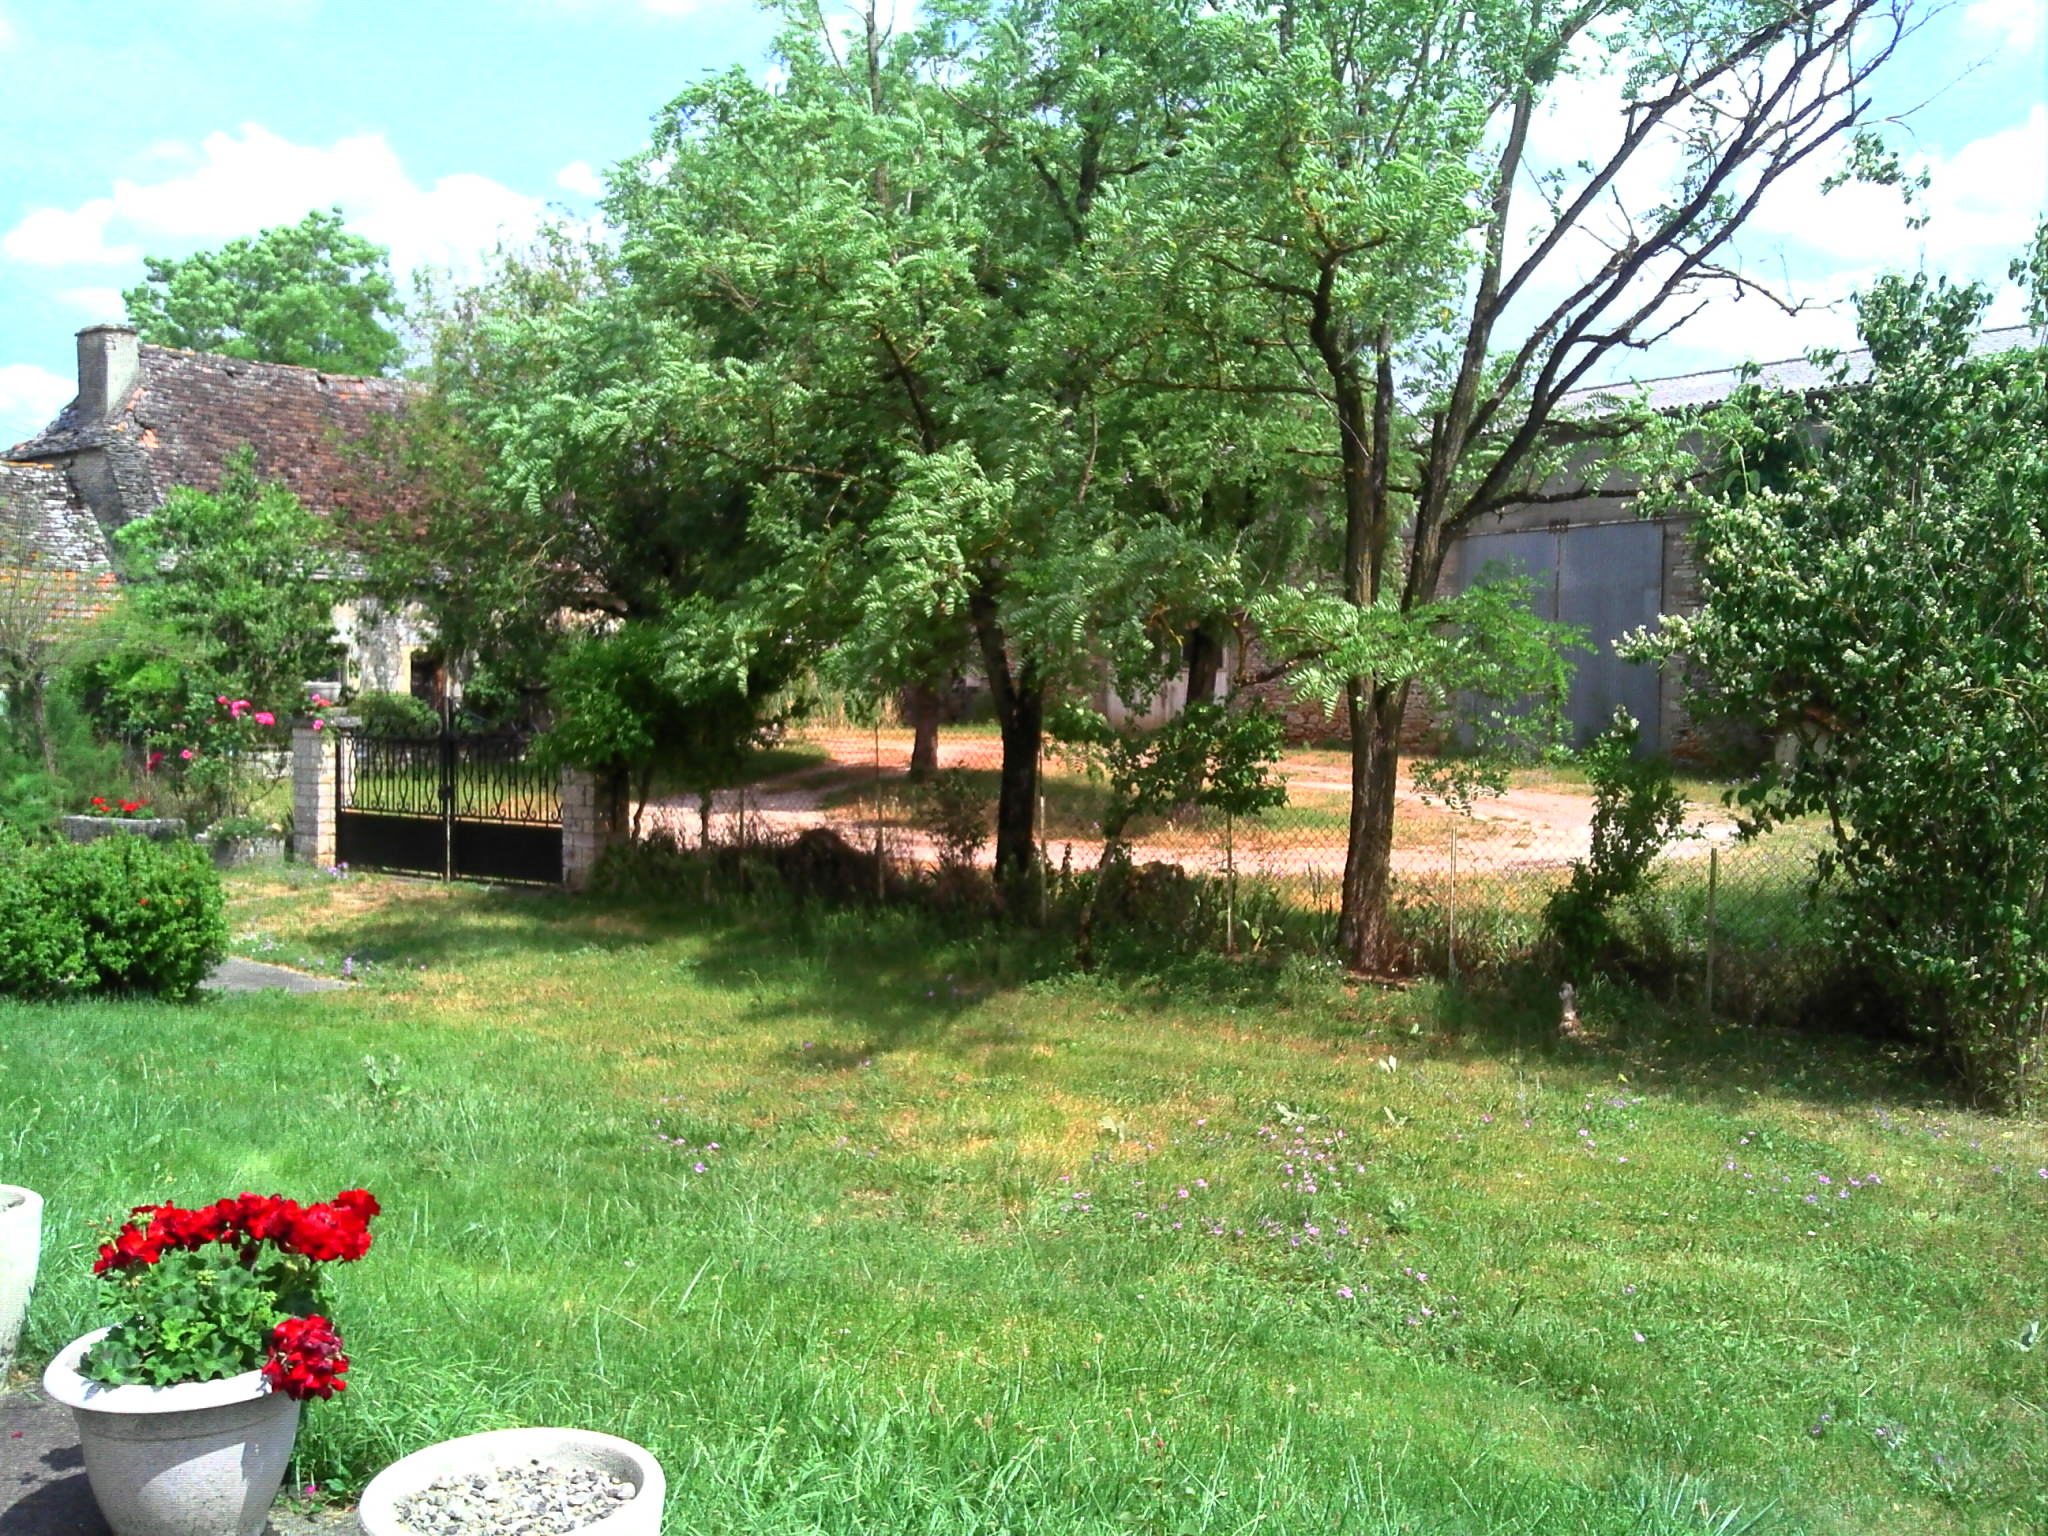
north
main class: Grassland
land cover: Grassland without tree/shrub cover
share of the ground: > 75 %
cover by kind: herbaceous plants 100 %
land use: Residential
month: June
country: FR
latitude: 44.6251
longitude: 1.8192
